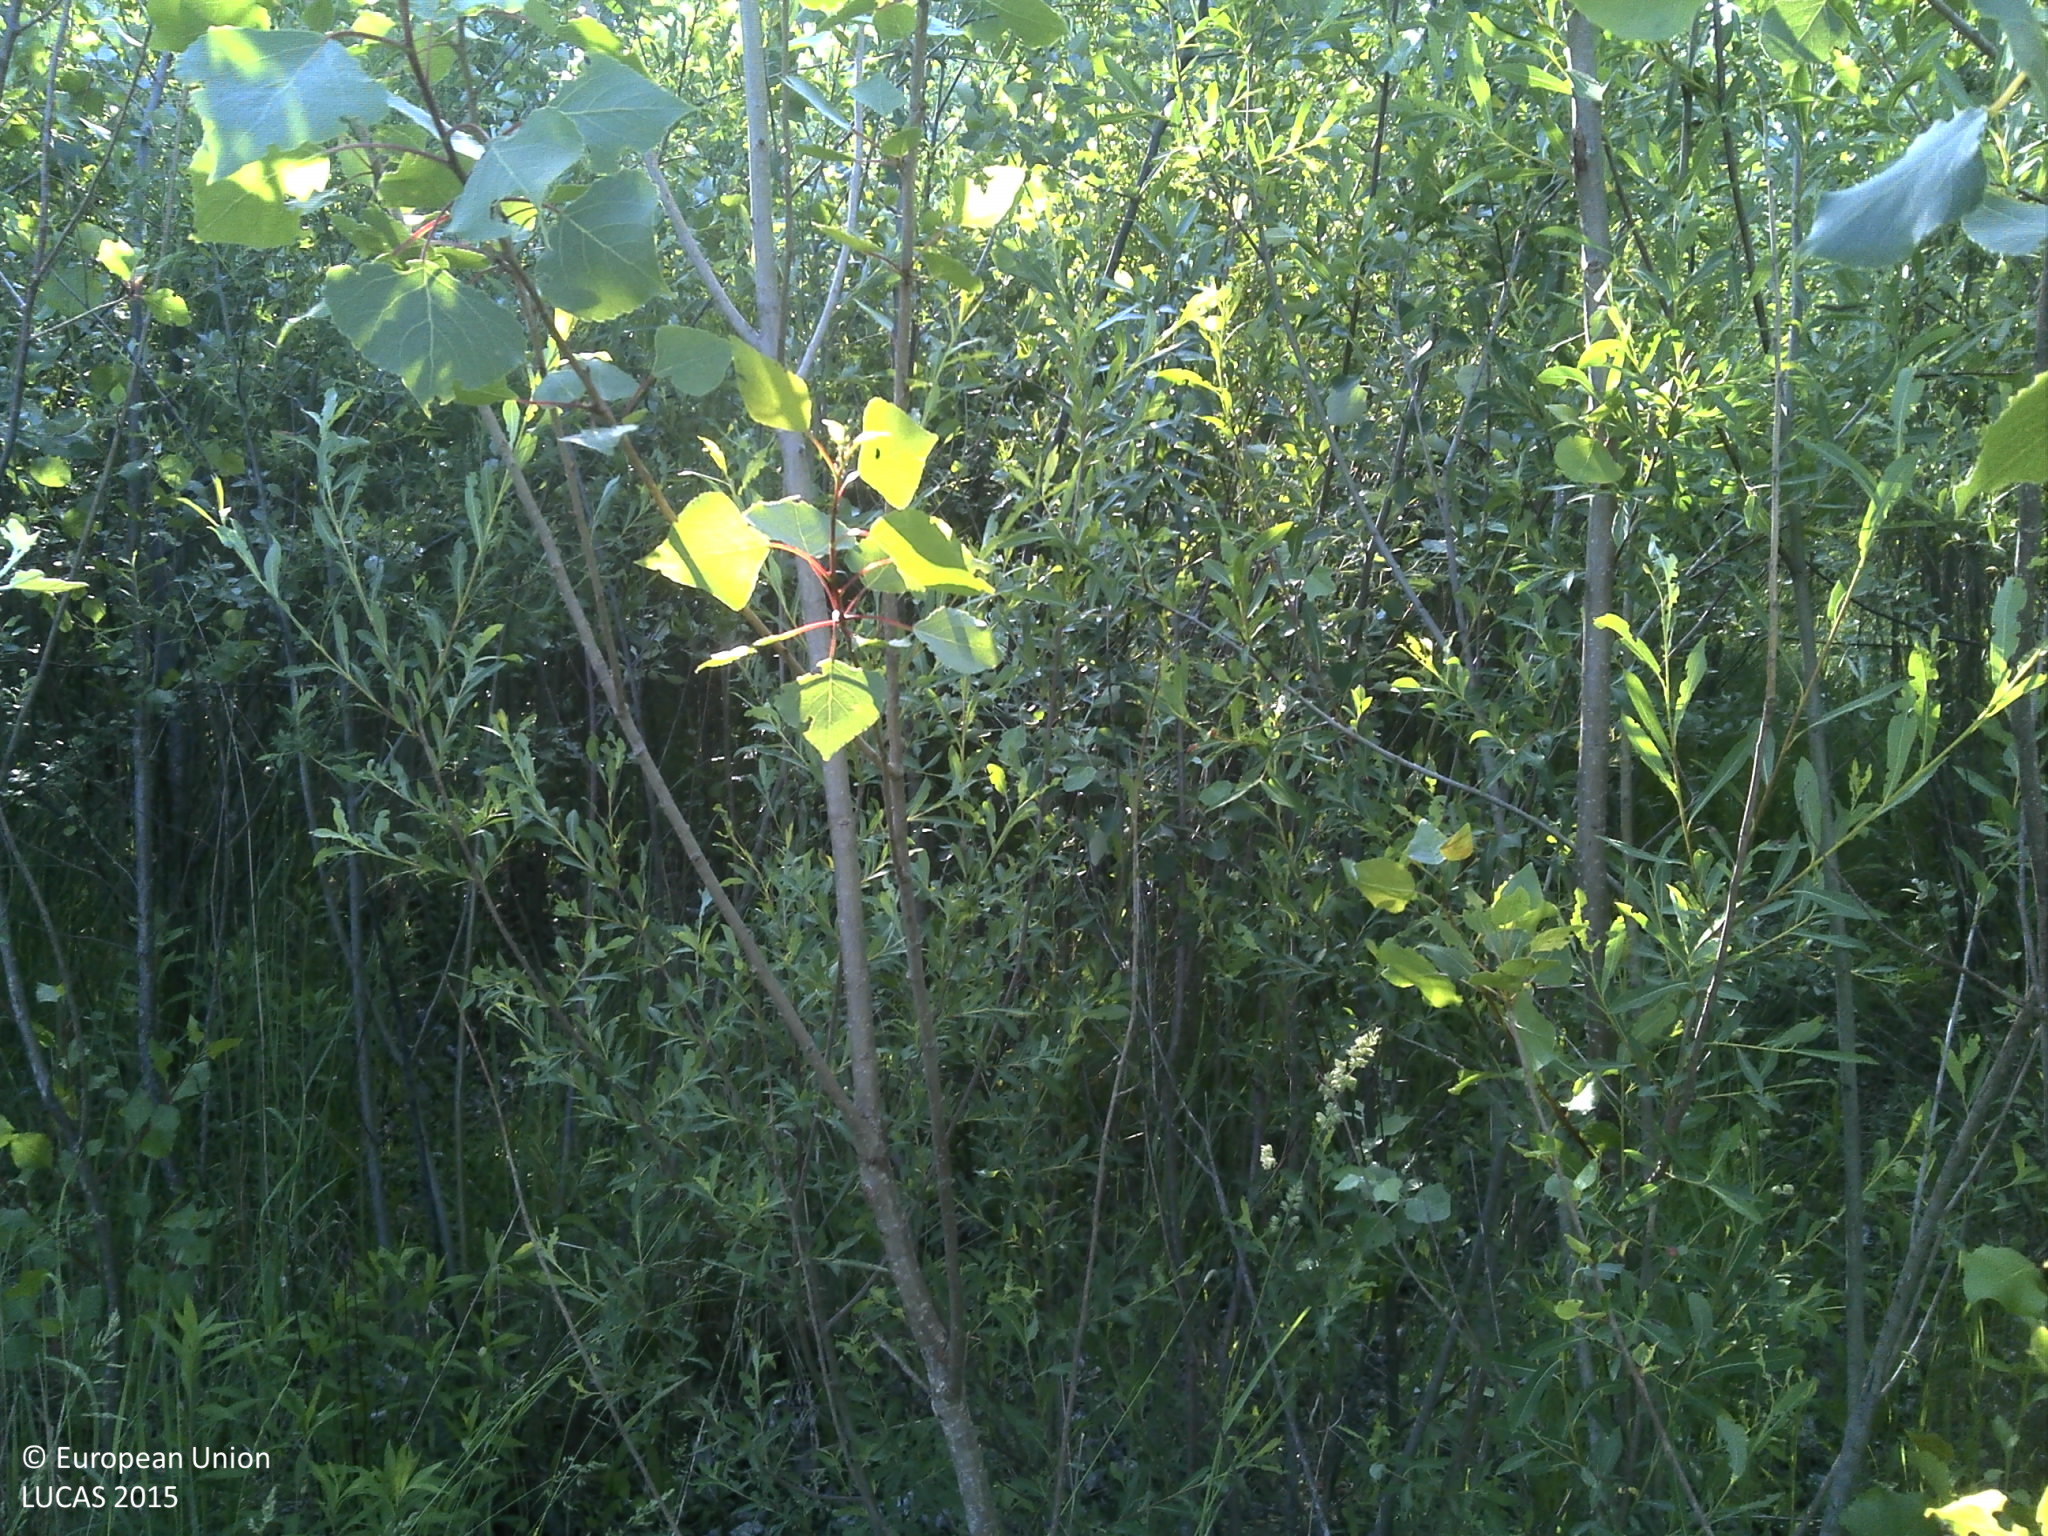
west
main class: Grassland
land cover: Grassland with sparse tree/shrub cover
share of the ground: > 75 %
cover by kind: herbaceous plants 85 %, shrubs 10 %, broadleaved forest trees 5 %
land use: Semi-natural and natural areas not in use
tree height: < 5 m
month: May
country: HR
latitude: 45.5472
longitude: 18.6531
